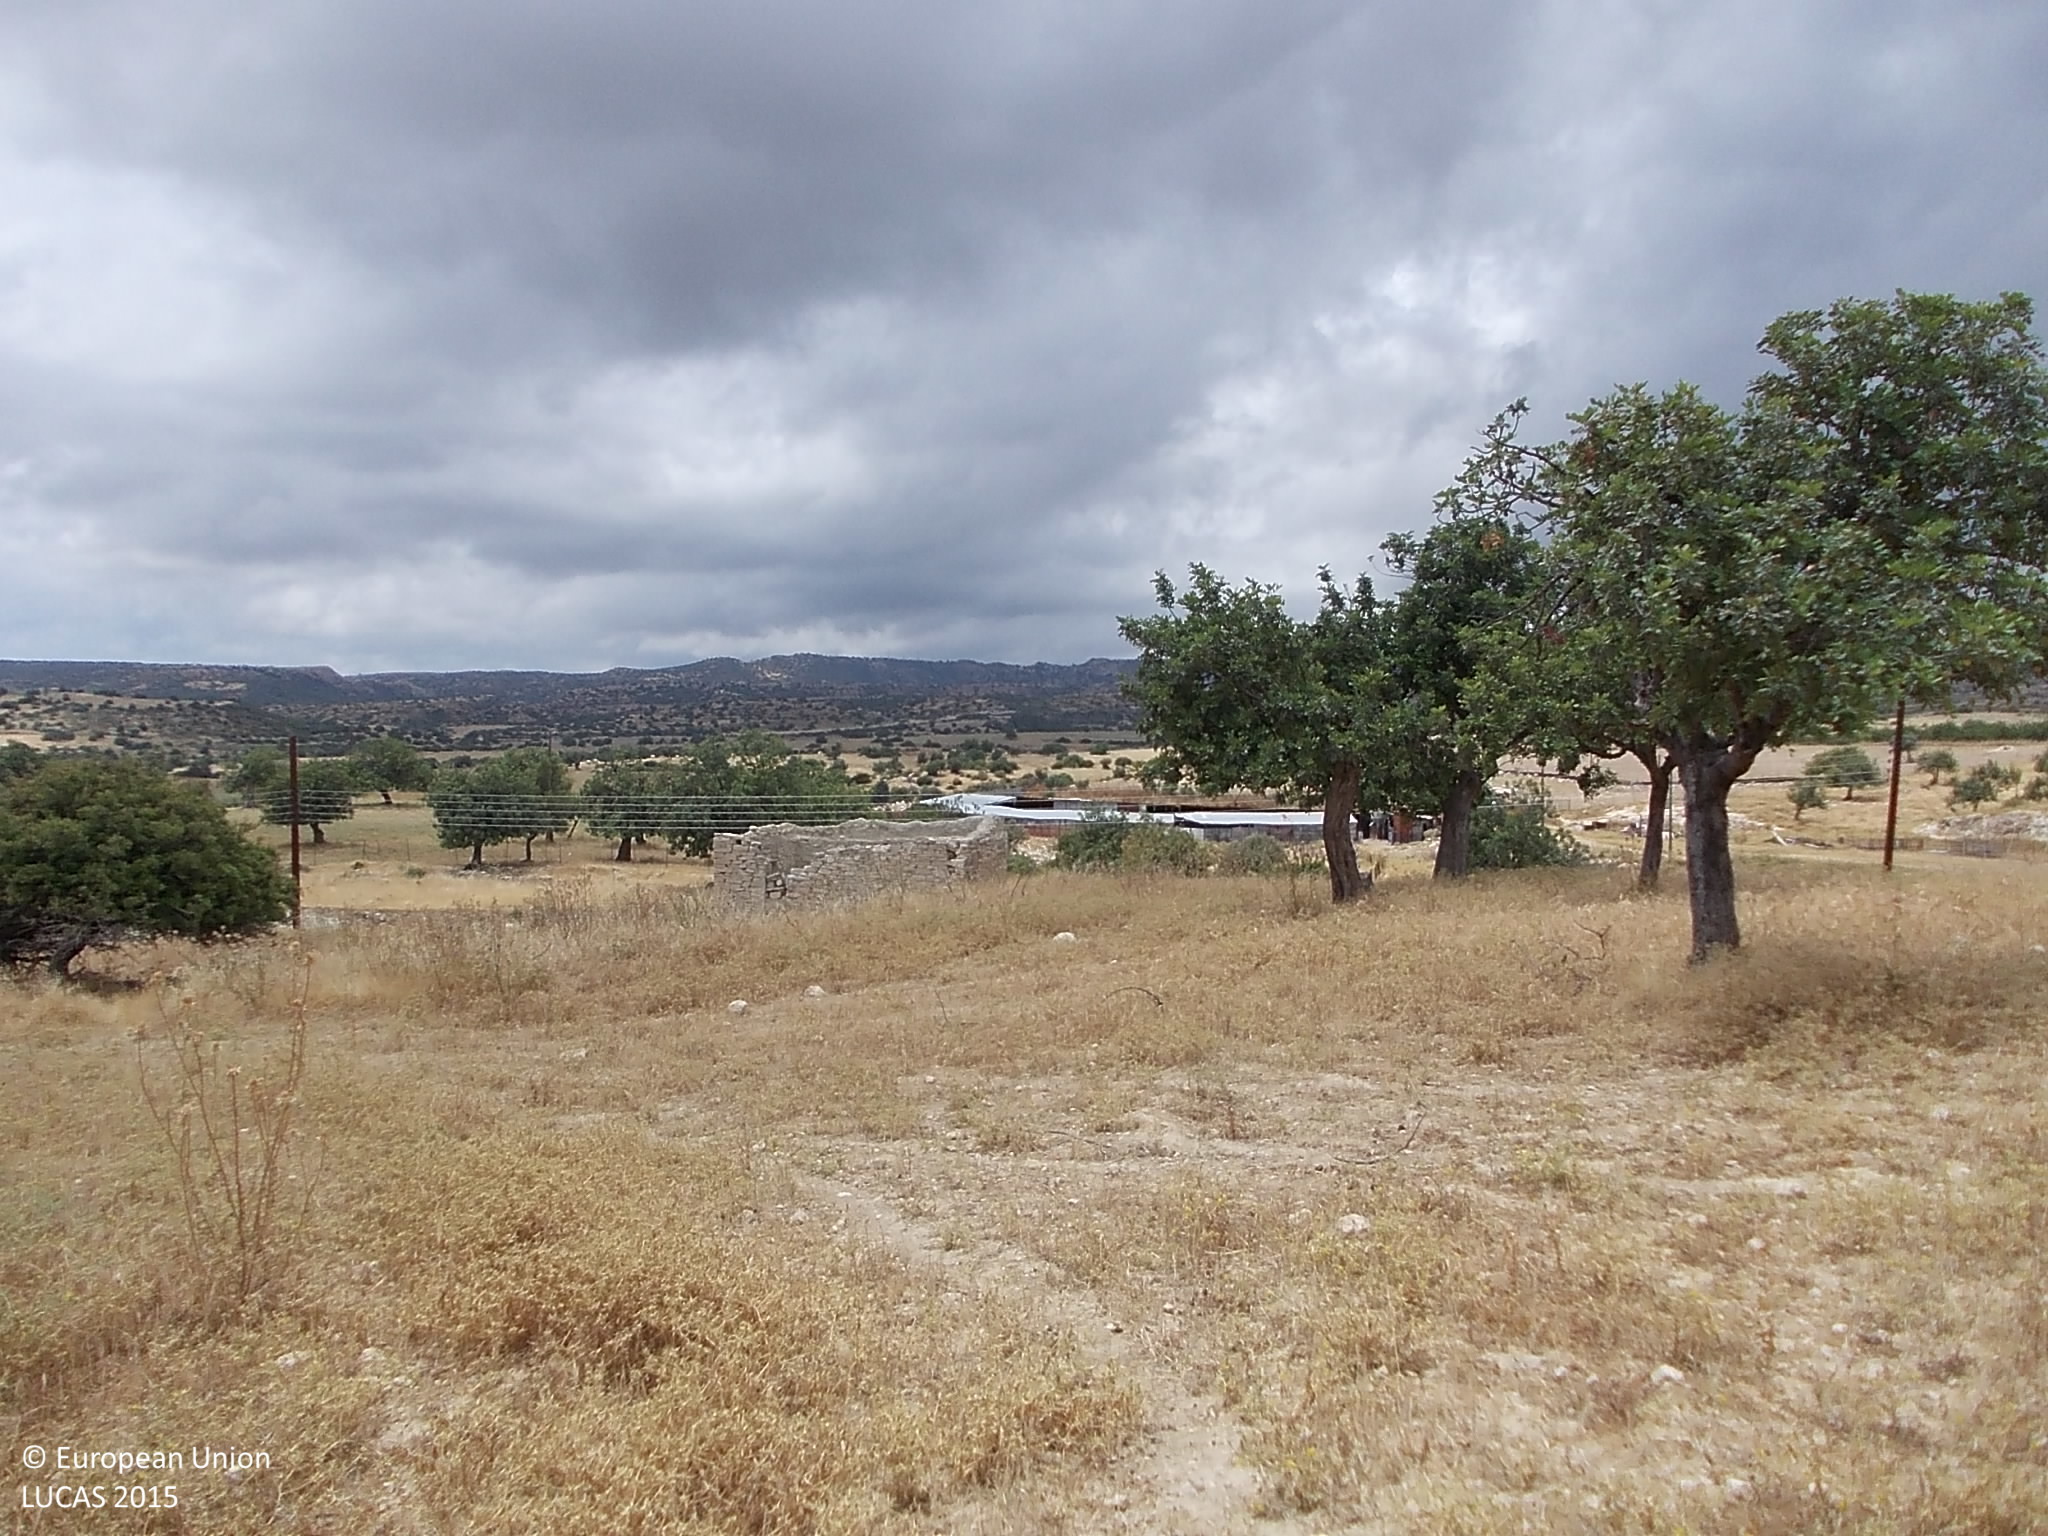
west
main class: Cropland
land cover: Permanent industrial crops
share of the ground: 10 - 25 %
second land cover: Spontaneously vegetated surfaces
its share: > 75 %
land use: Agriculture (excluding fallow land and kitchen gardens)
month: May
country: CY
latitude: 34.7037
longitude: 32.7652
